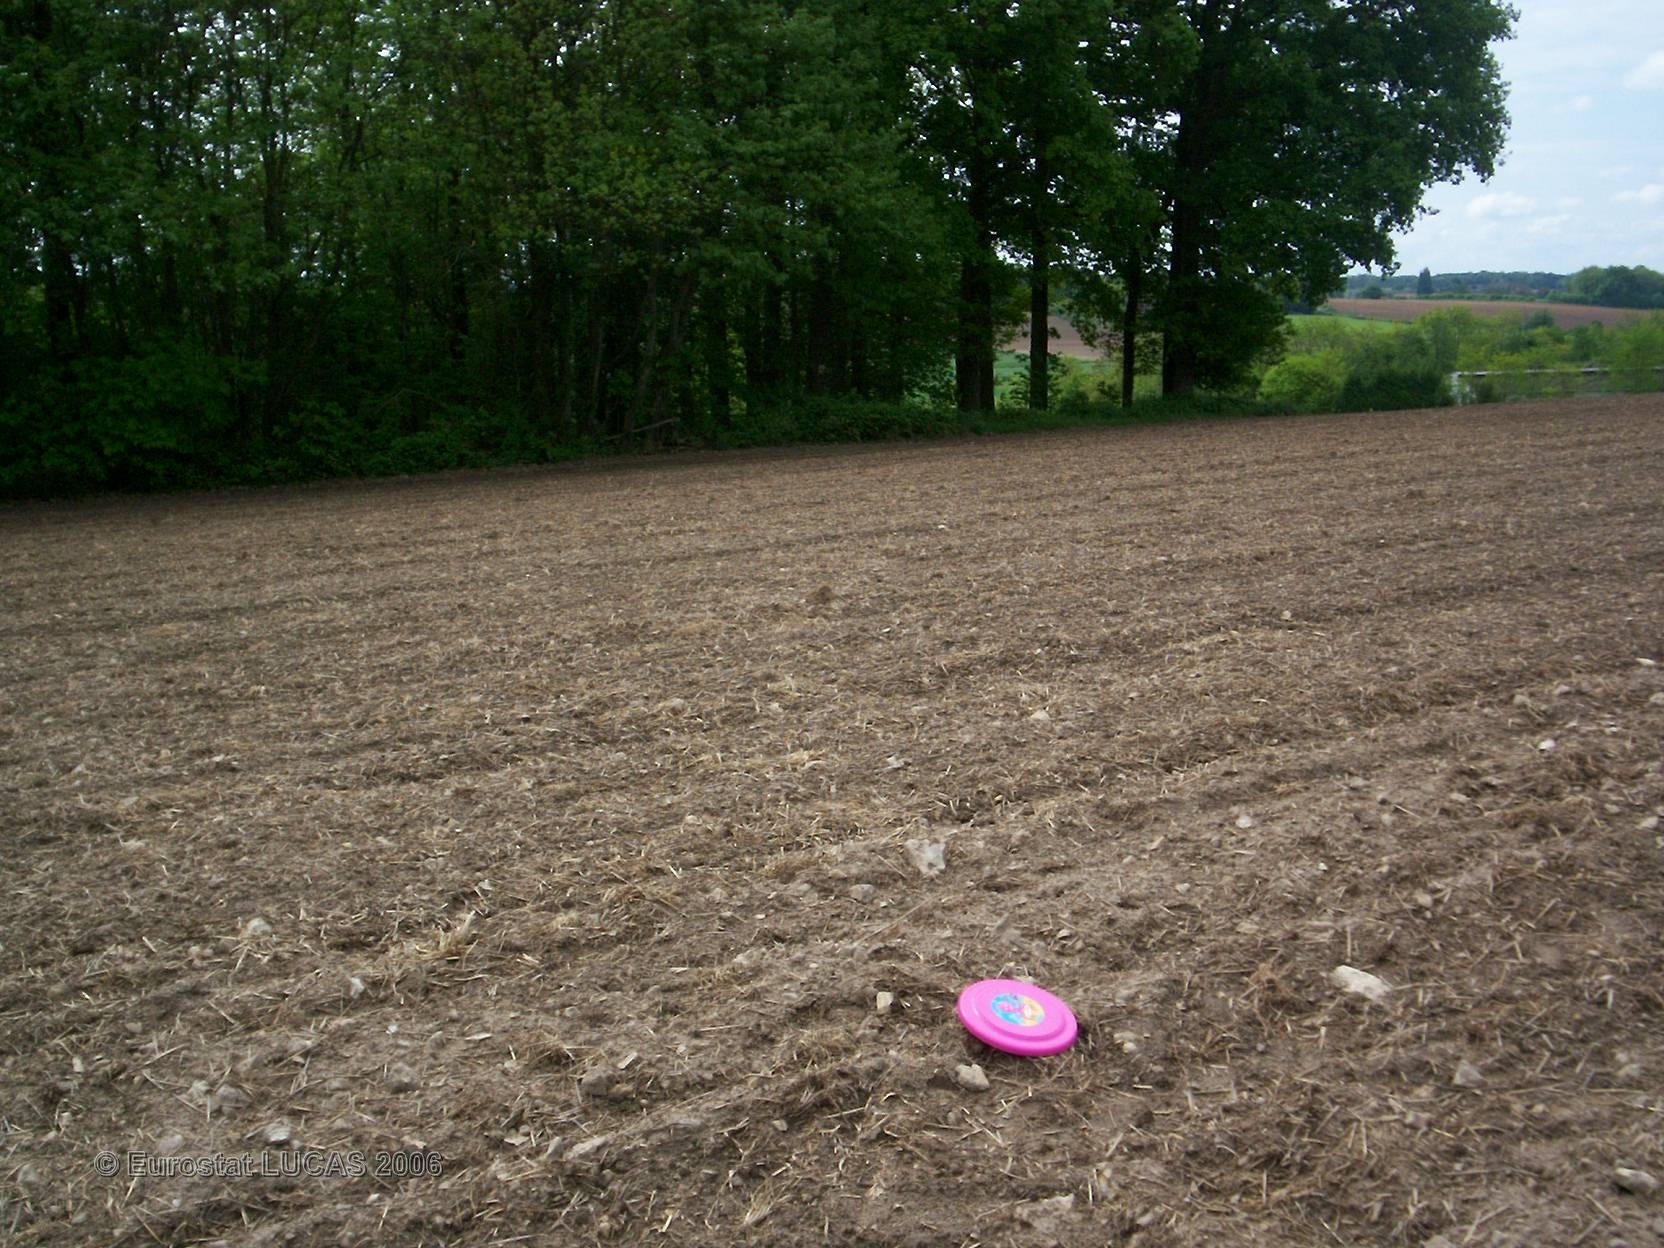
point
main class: Cropland
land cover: Sunflower
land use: Agriculture (excluding fallow land and kitchen gardens)
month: May
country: FR
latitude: 47.8005
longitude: 0.1611
